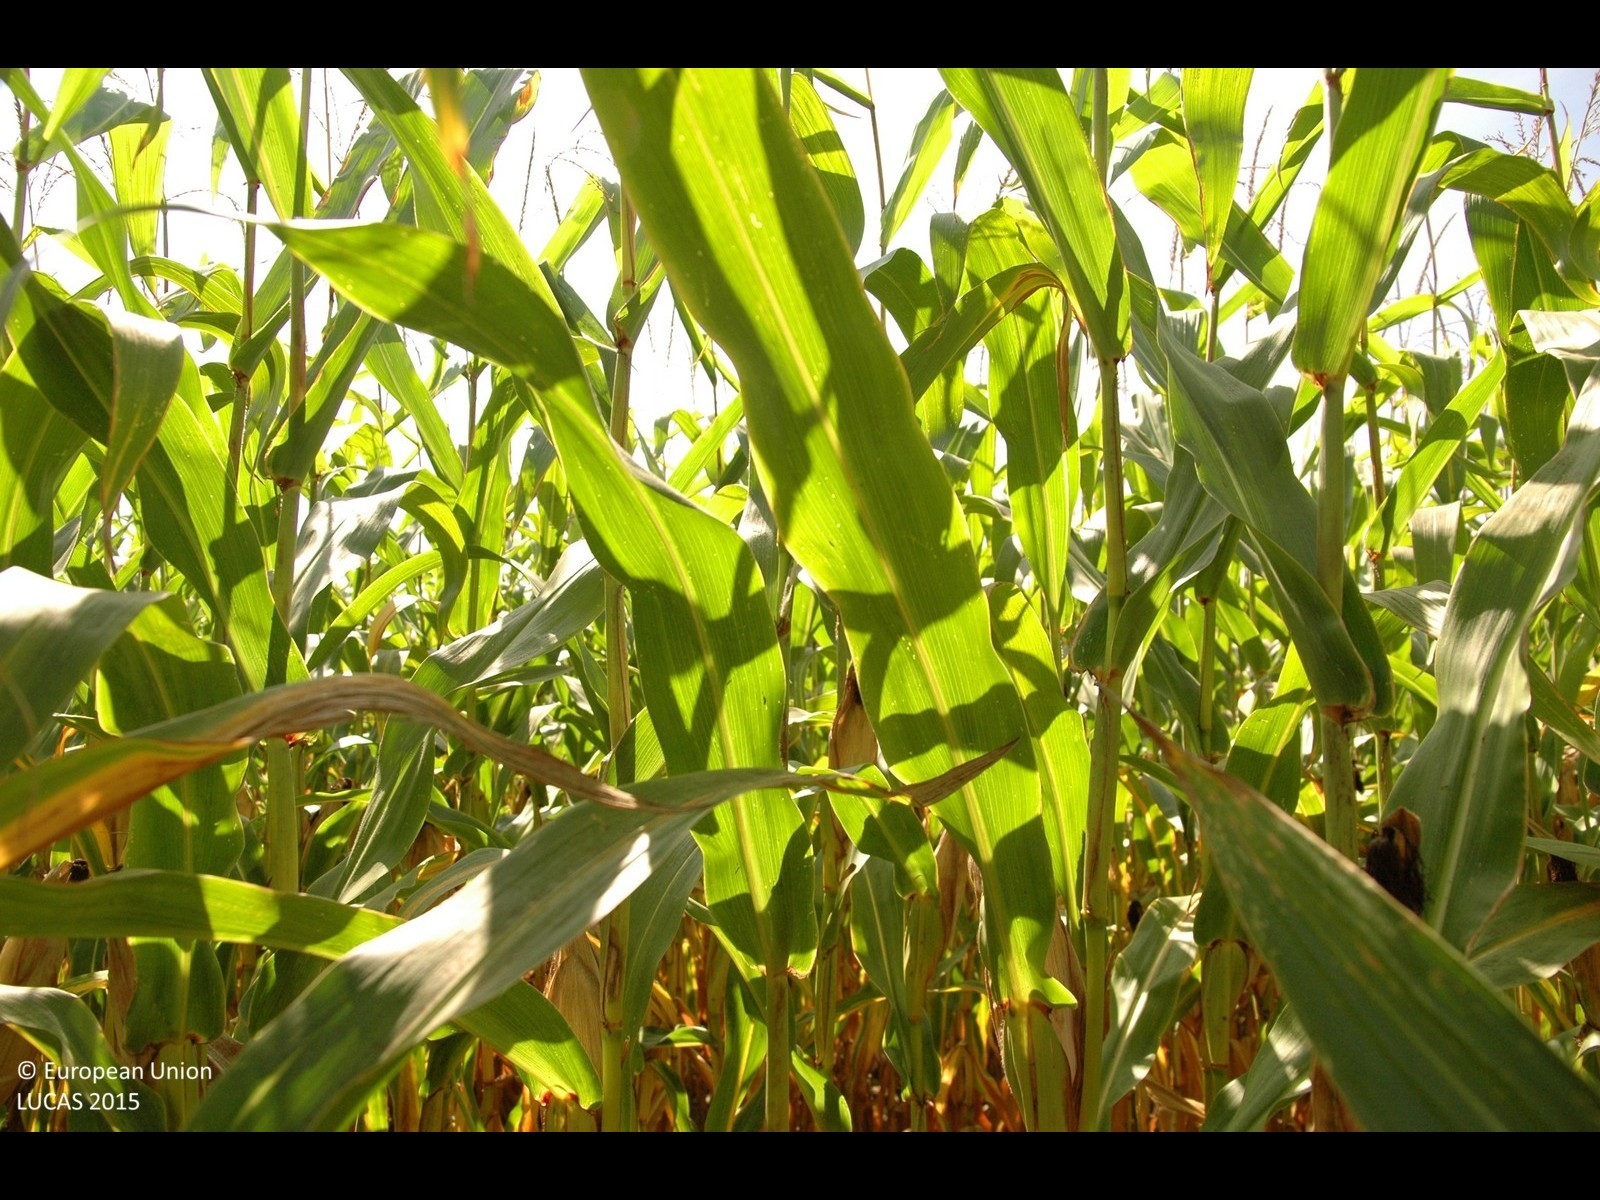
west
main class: Cropland
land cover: Maize
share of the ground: > 75 %
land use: Agriculture (excluding fallow land and kitchen gardens)
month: August
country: HR
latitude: 46.2734
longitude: 16.8923
